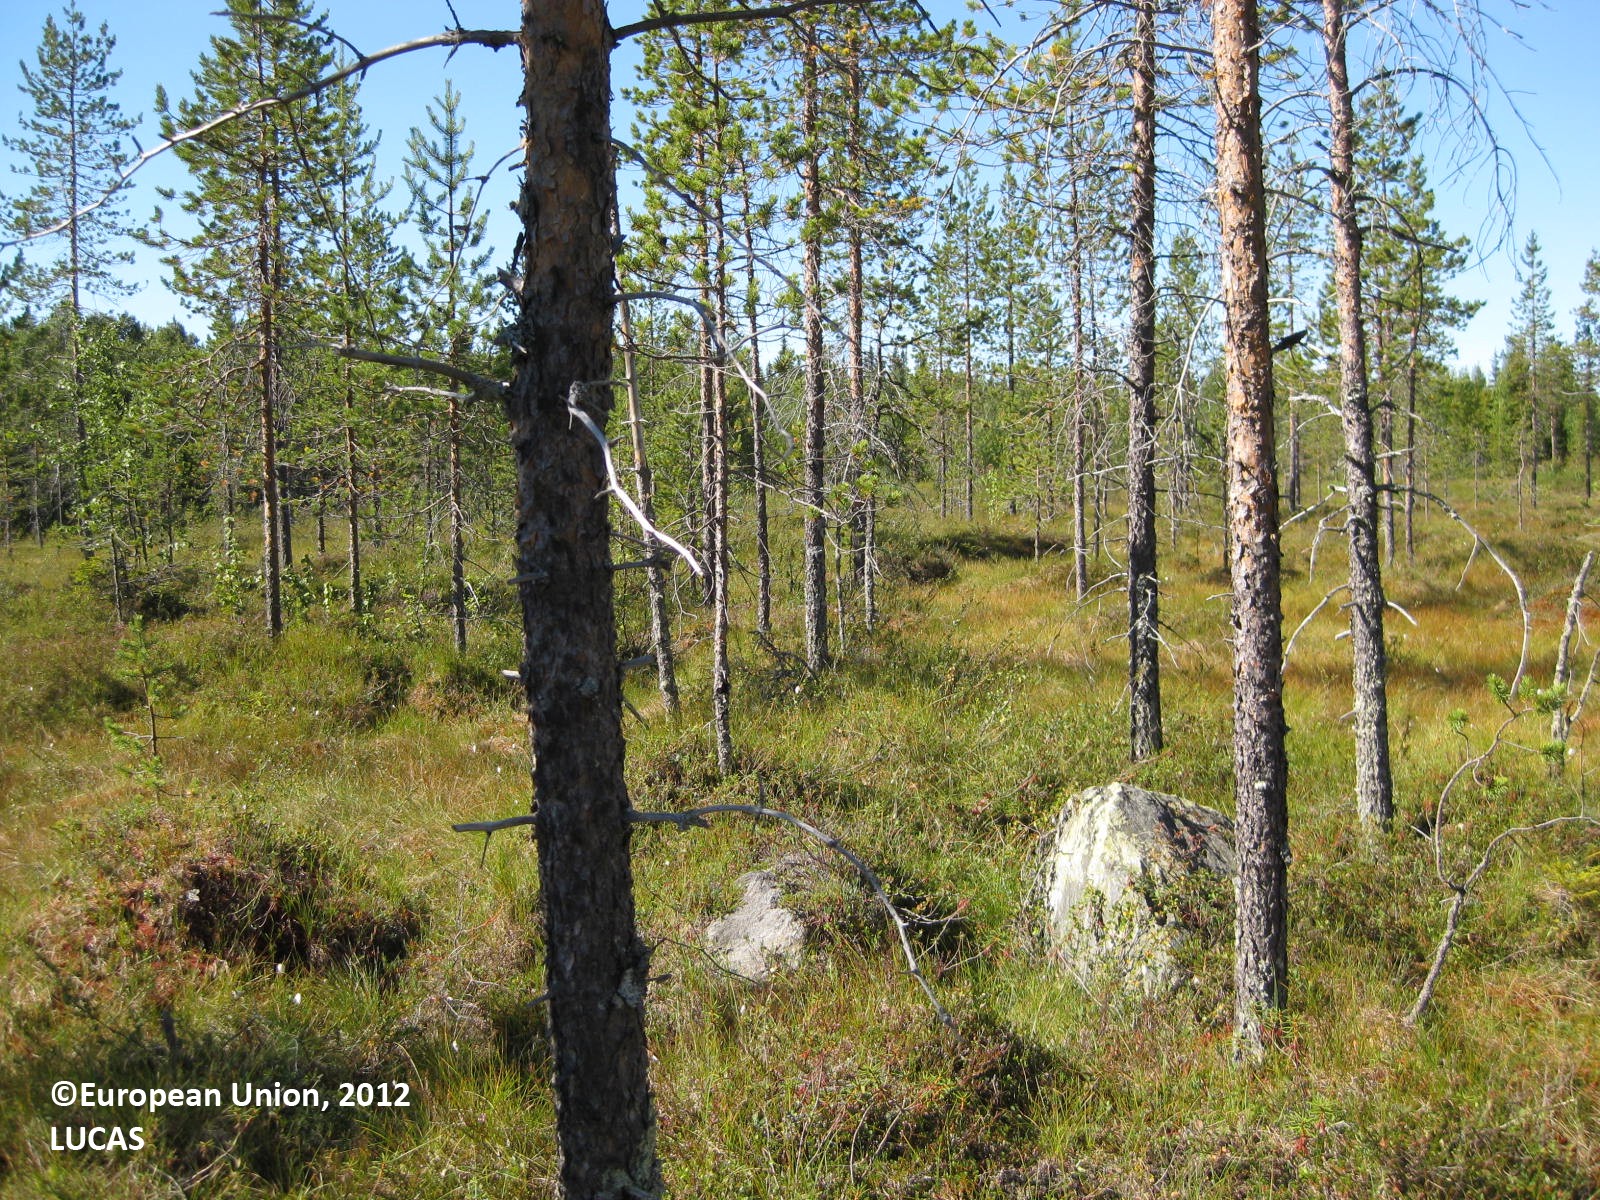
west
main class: Woodland
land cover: Pine dominated coniferous woodland
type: boreal forest
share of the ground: 25 - 50 %
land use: Forestry
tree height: > 5 m
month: August
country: FI
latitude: 66.4311
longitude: 28.5489
